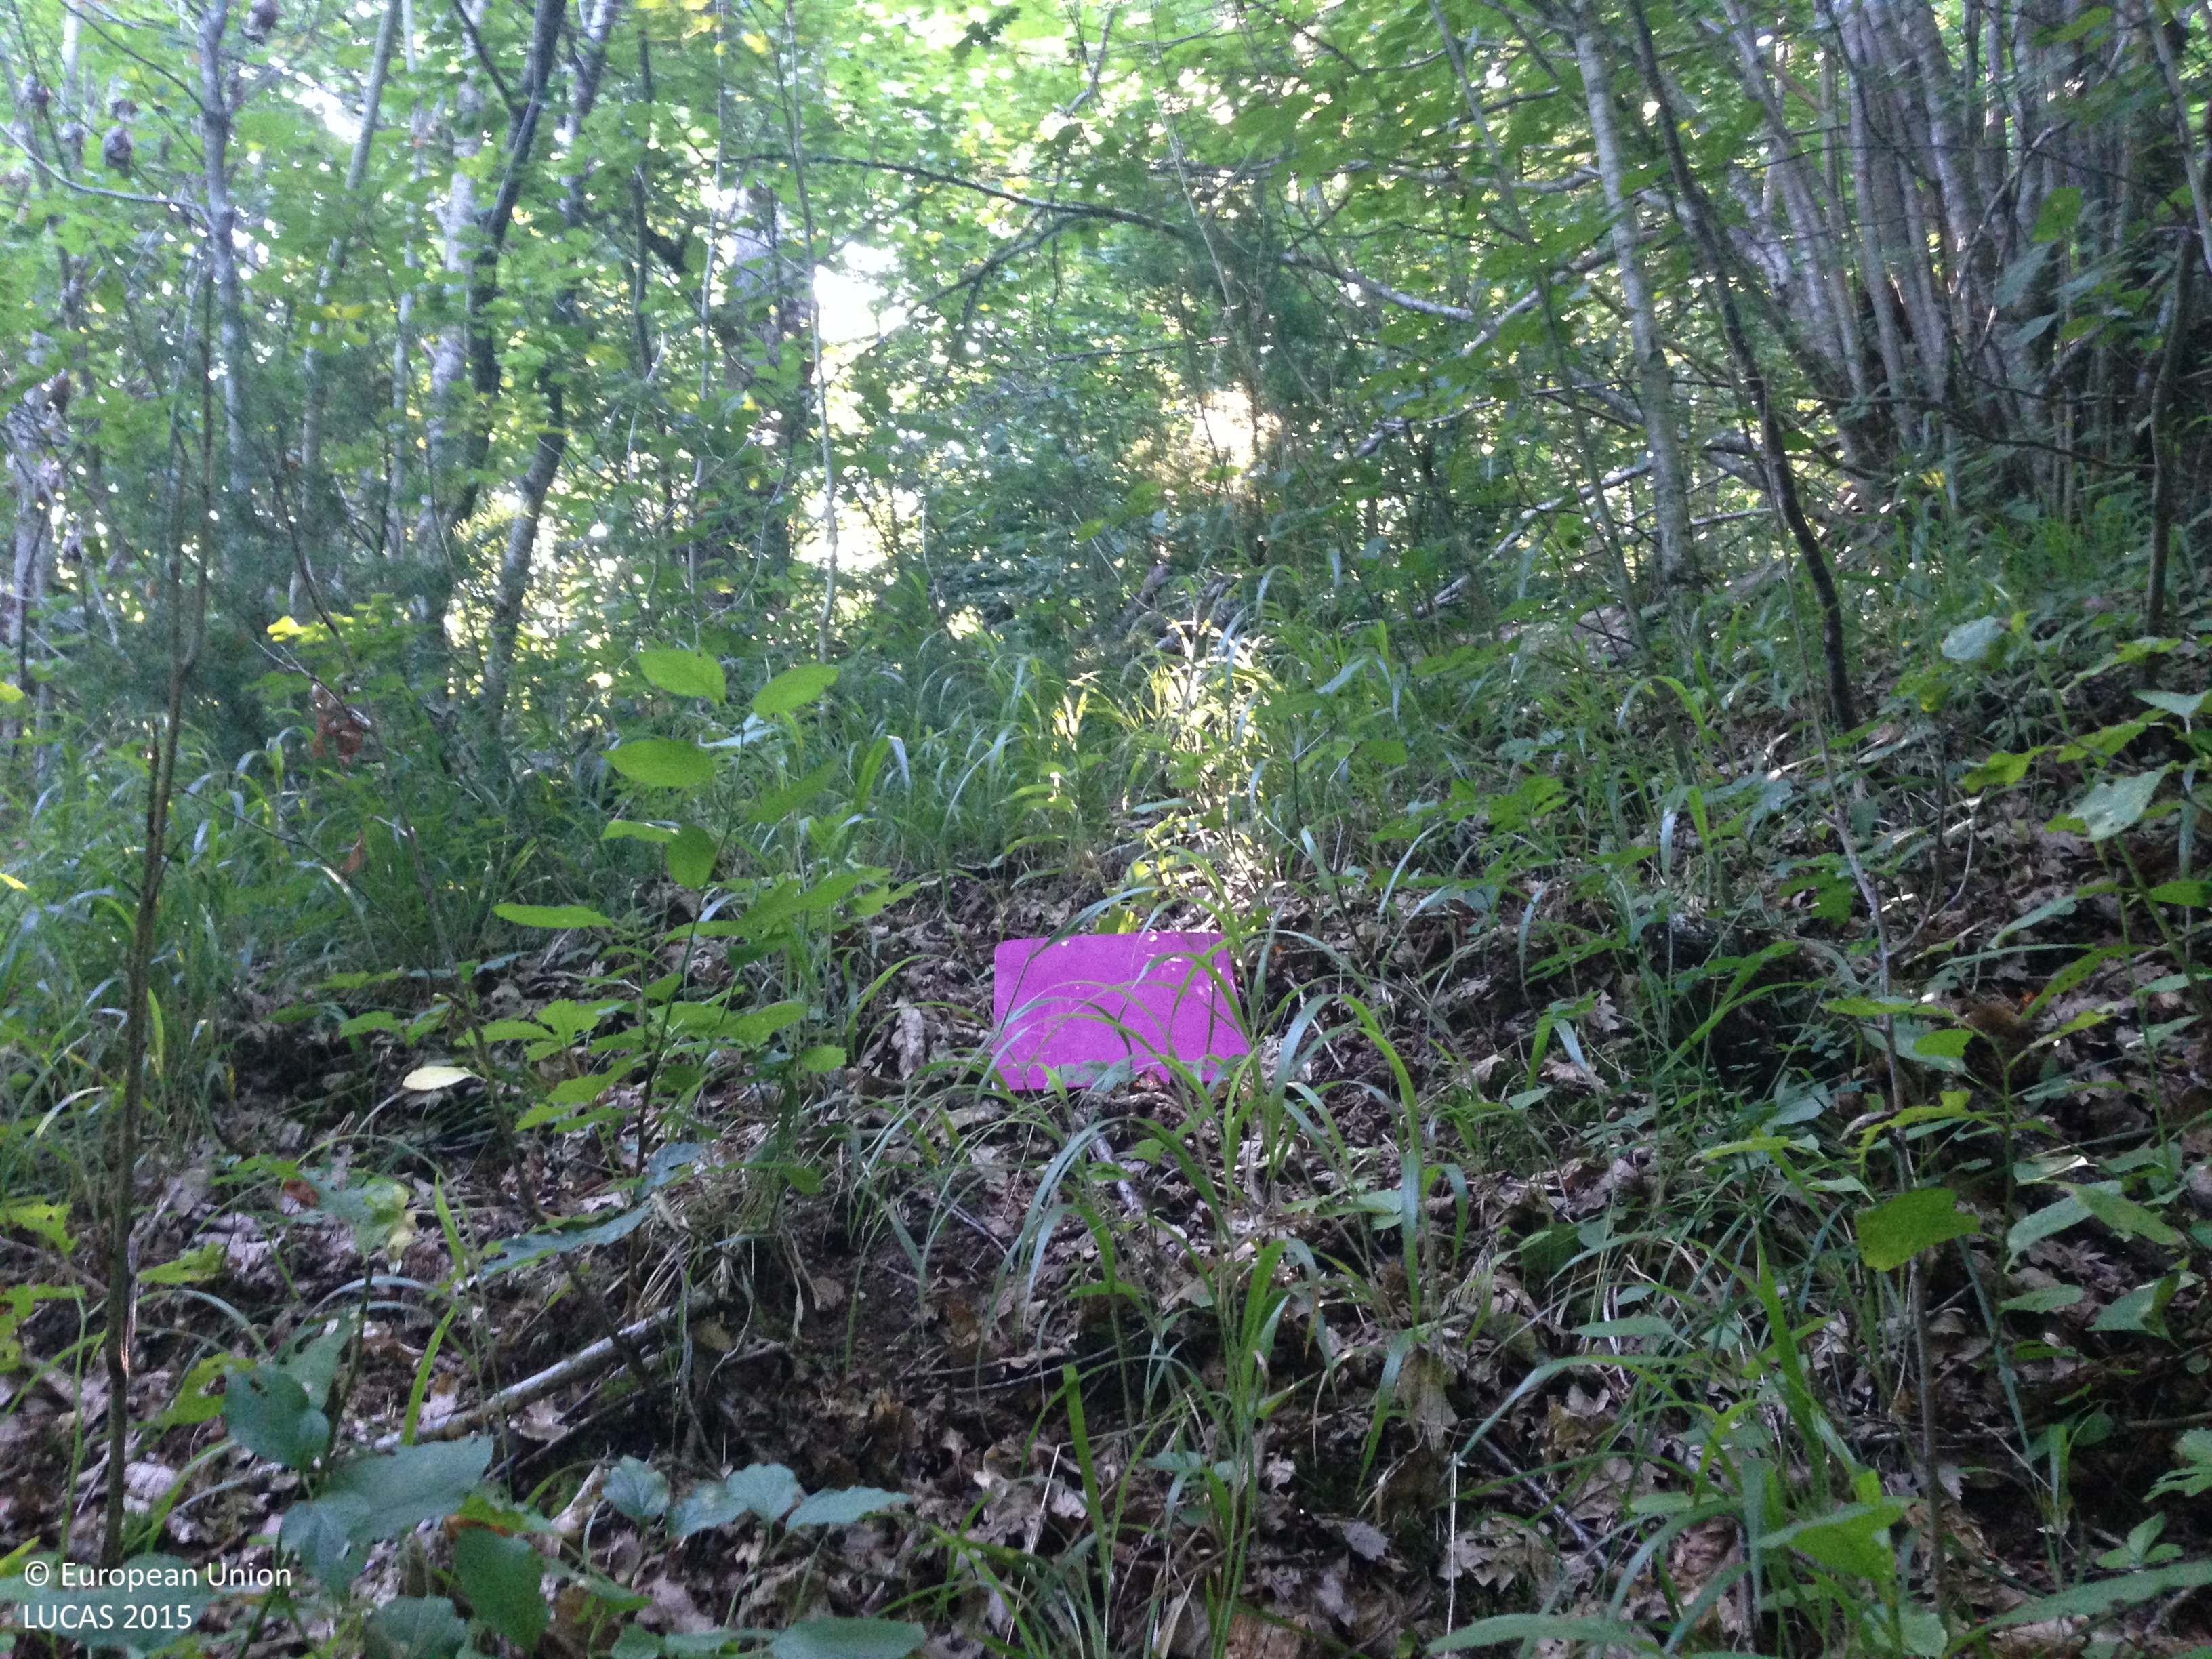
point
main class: Woodland
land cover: Broadleaved woodland
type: beech forest
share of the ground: 50 - 75 %
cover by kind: broadleaved forest trees 60 %, shrubs 30 %, lichens and mosses 5 %, consolidated bare surface 5 %
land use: Semi-natural and natural areas not in use
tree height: > 5 m
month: July
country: HR
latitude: 44.7102
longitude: 15.1562
